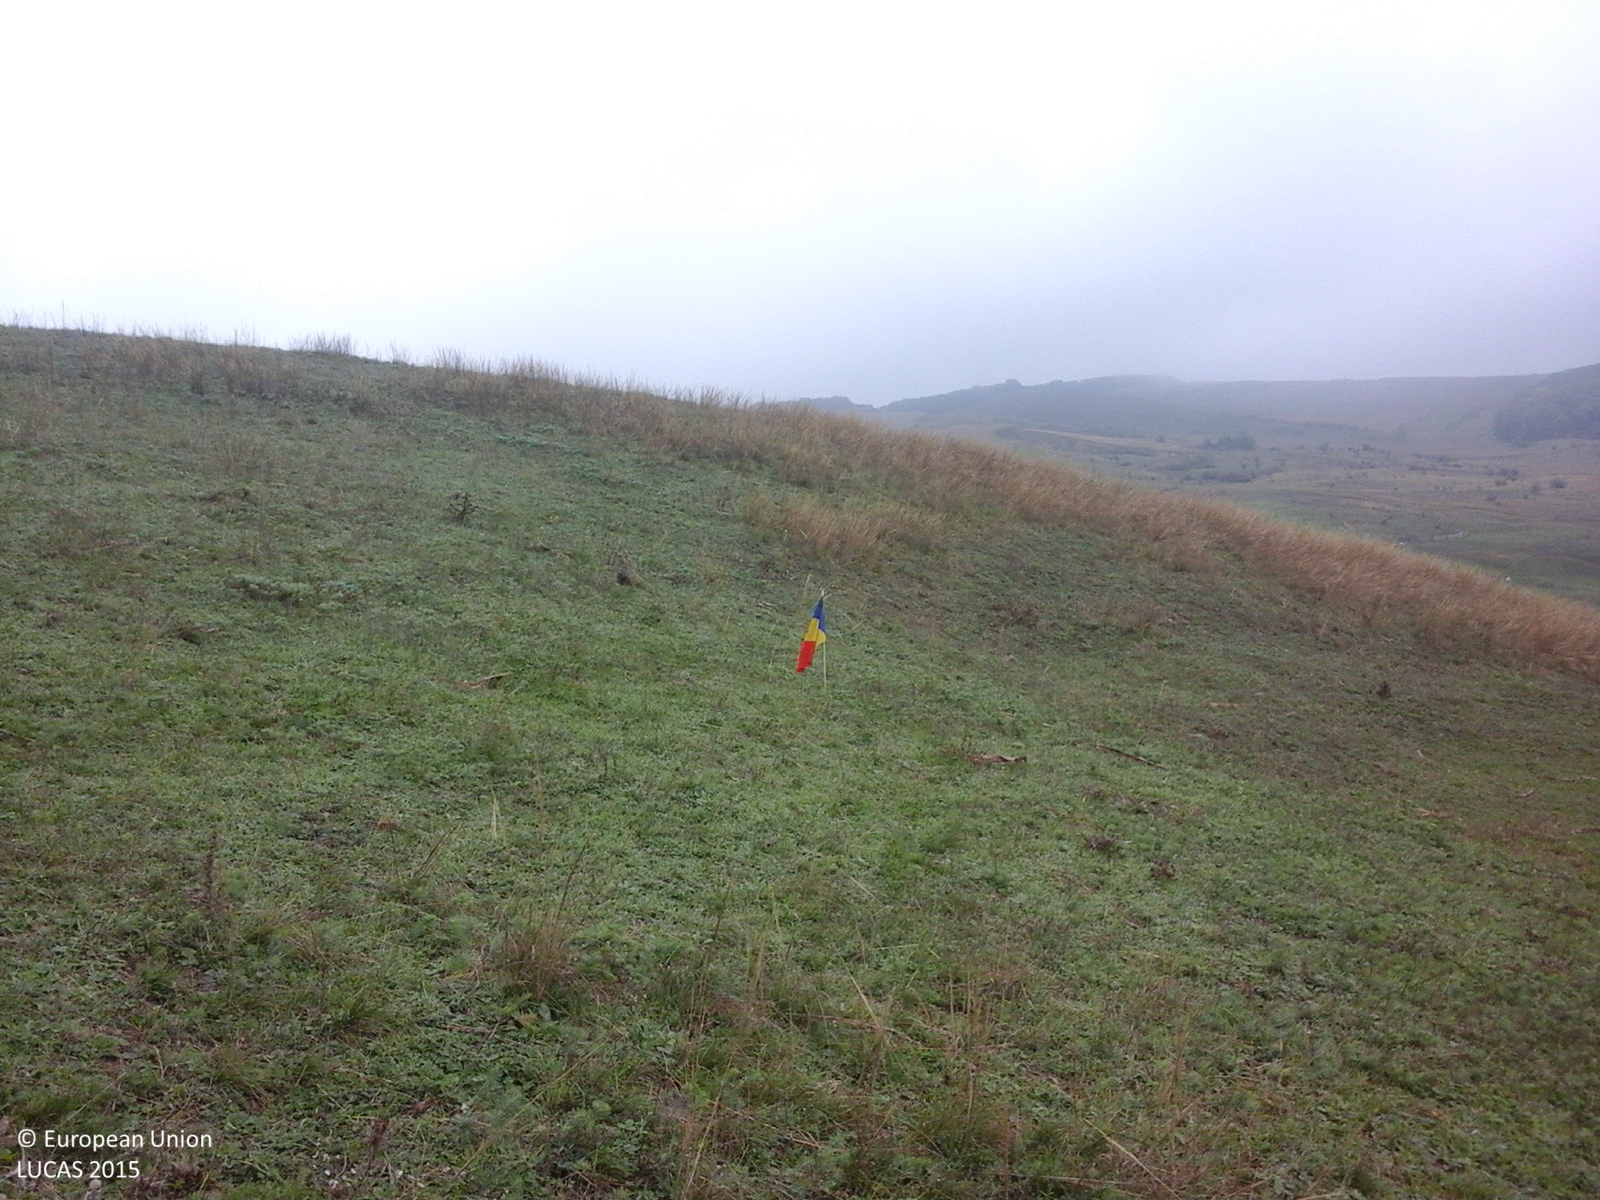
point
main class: Grassland
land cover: Grassland without tree/shrub cover
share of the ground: > 75 %
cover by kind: herbaceous plants 100 %
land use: Agriculture (excluding fallow land and kitchen gardens)
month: October
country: RO
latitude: 46.6246
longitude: 23.9066
